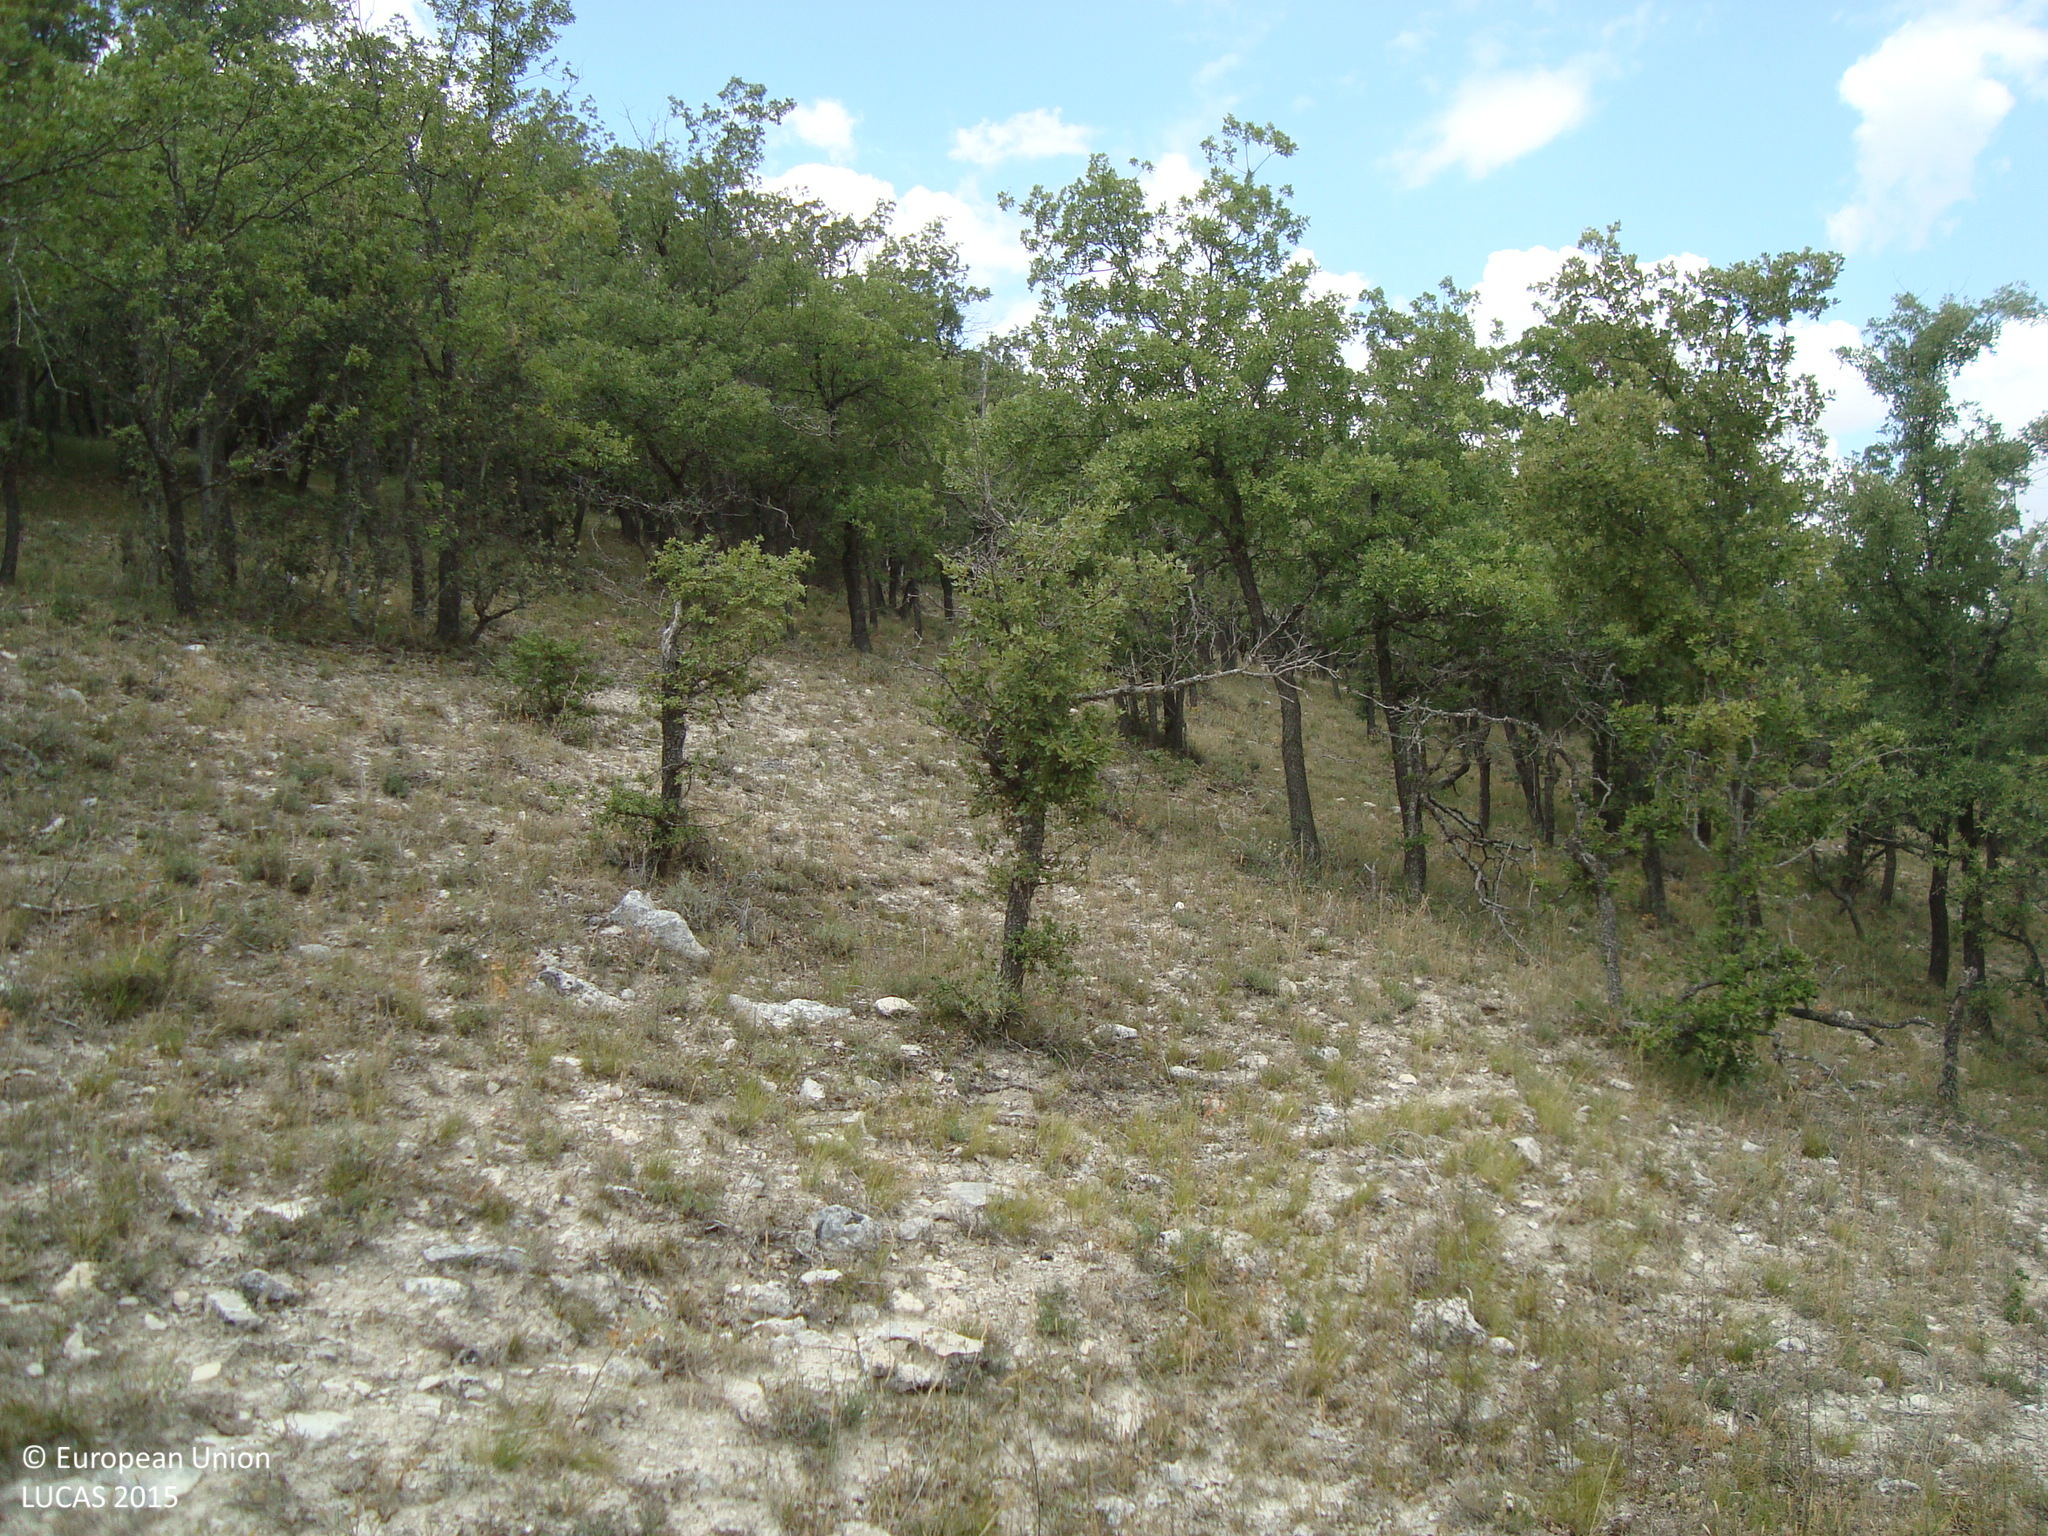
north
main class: Woodland
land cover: Broadleaved woodland
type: broadleaved evergreen forest
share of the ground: 50 - 75 %
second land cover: Spontaneously vegetated surfaces
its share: 25 - 50 %
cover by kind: broadleaved forest trees 60 %, herbaceous plants 25 %, unconsolidated bare surface 10 %, shrubs 5 %
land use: Forestry
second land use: Agriculture (excluding fallow land and kitchen gardens)
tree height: > 5 m
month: July
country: ES
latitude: 41.9492
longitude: -4.1407
